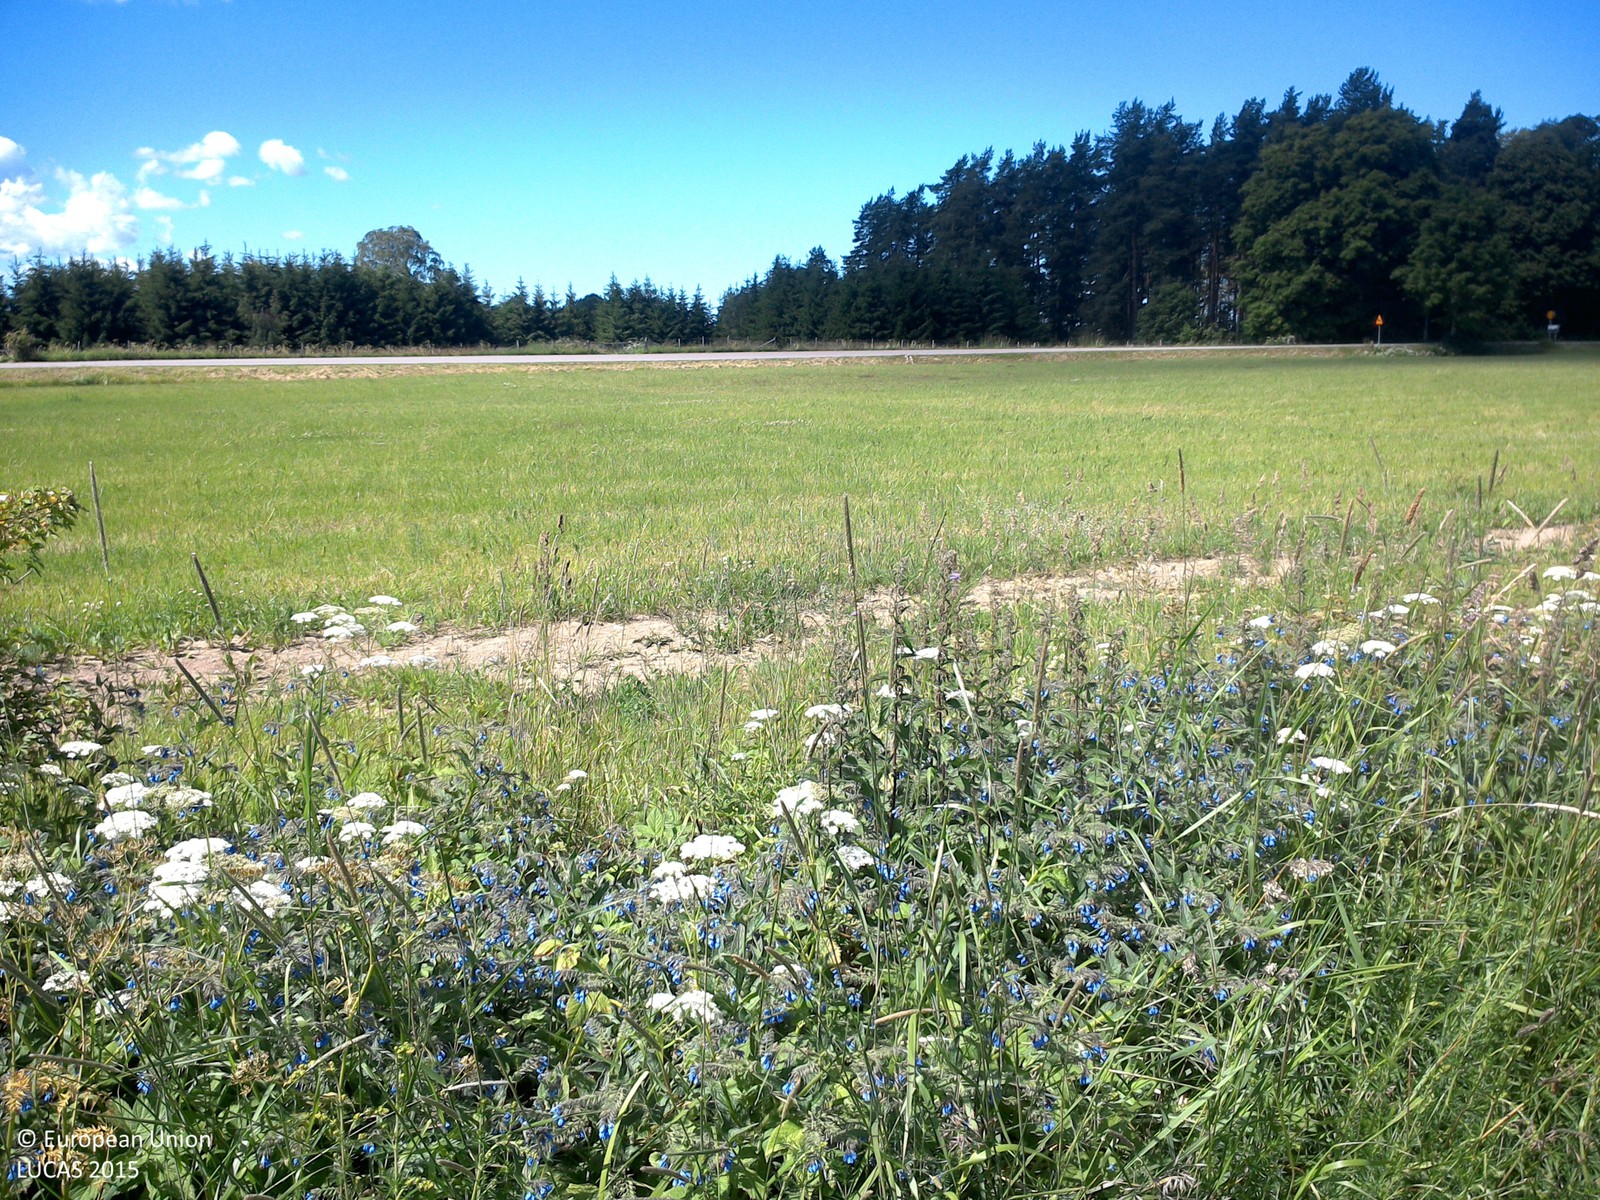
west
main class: Grassland
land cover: Grassland without tree/shrub cover
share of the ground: > 75 %
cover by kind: herbaceous plants 100 %
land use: Amenities, museums, leisure
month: July
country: SE
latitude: 58.3989
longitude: 15.4182
